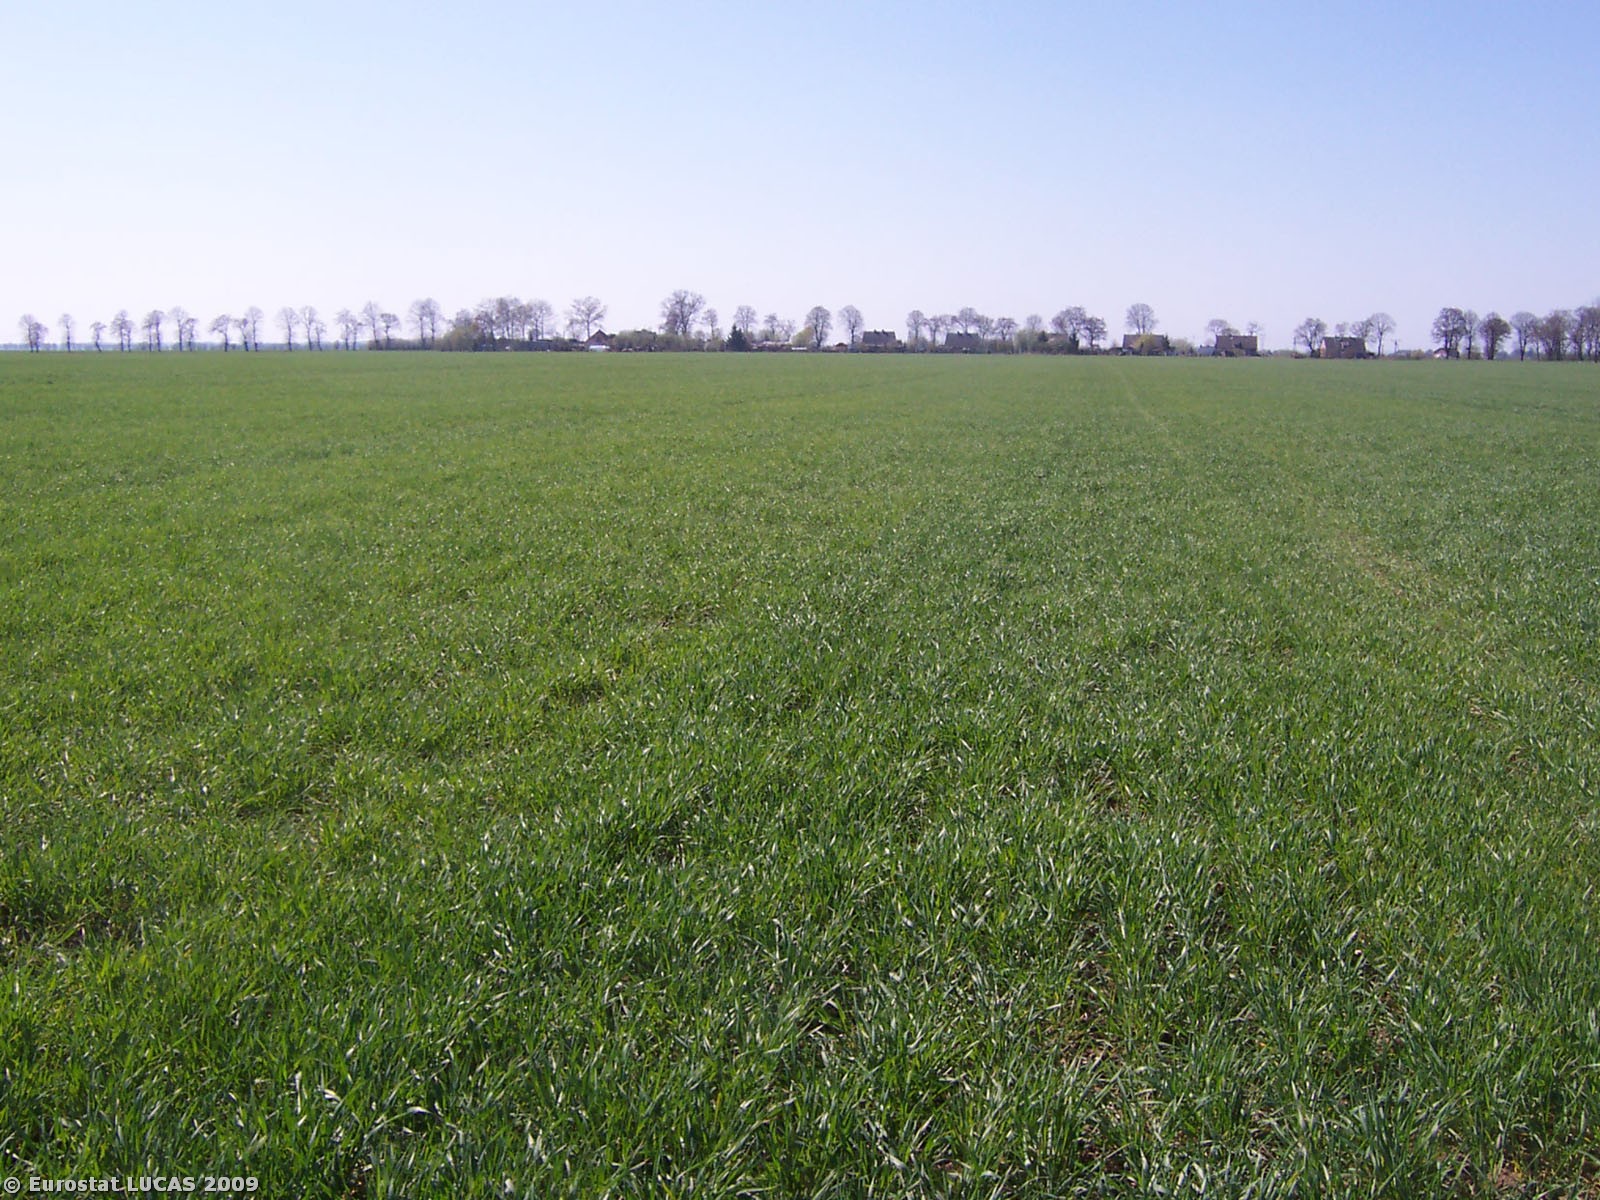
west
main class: Cropland
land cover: Common wheat
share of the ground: 25 - 50 %
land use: Agriculture (excluding fallow land and kitchen gardens)
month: April
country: PL
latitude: 54.1000
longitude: 18.9672
